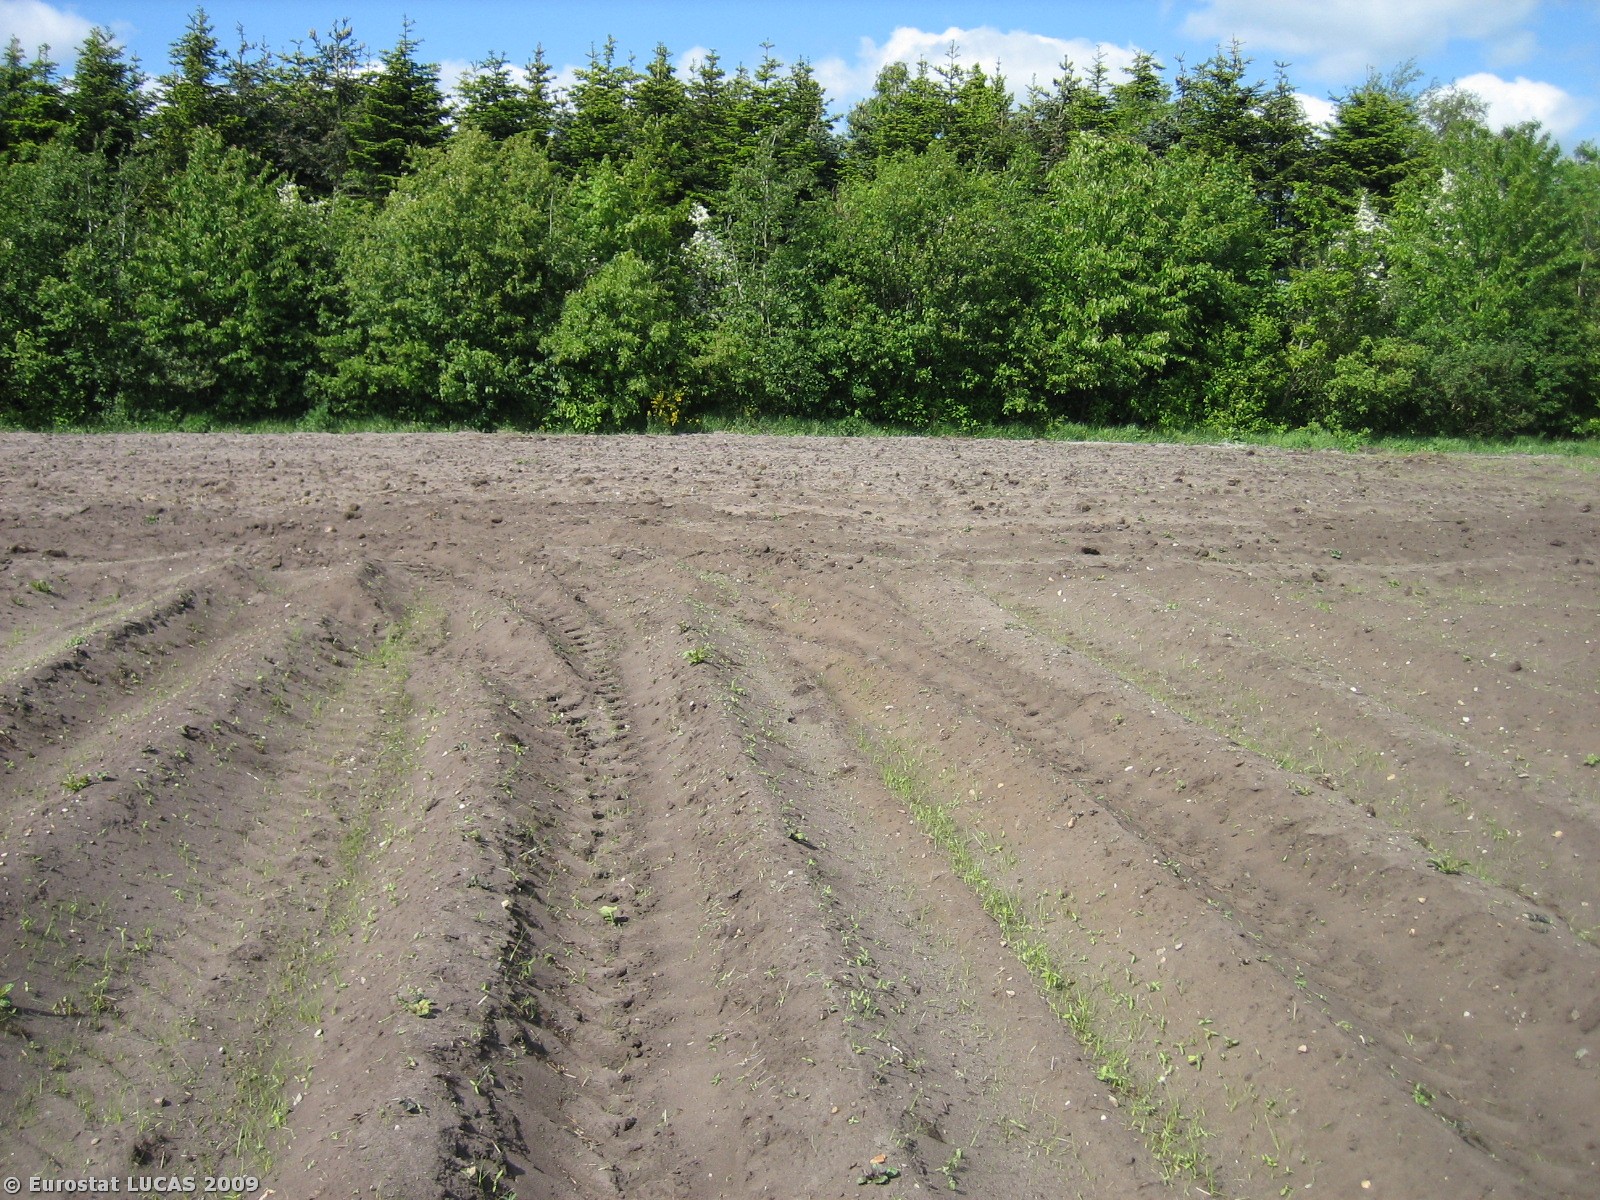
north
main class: Cropland
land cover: Potatoes
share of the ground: < 10 %
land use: Agriculture (excluding fallow land and kitchen gardens)
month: May
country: DK
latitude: 56.0040
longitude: 8.9908
